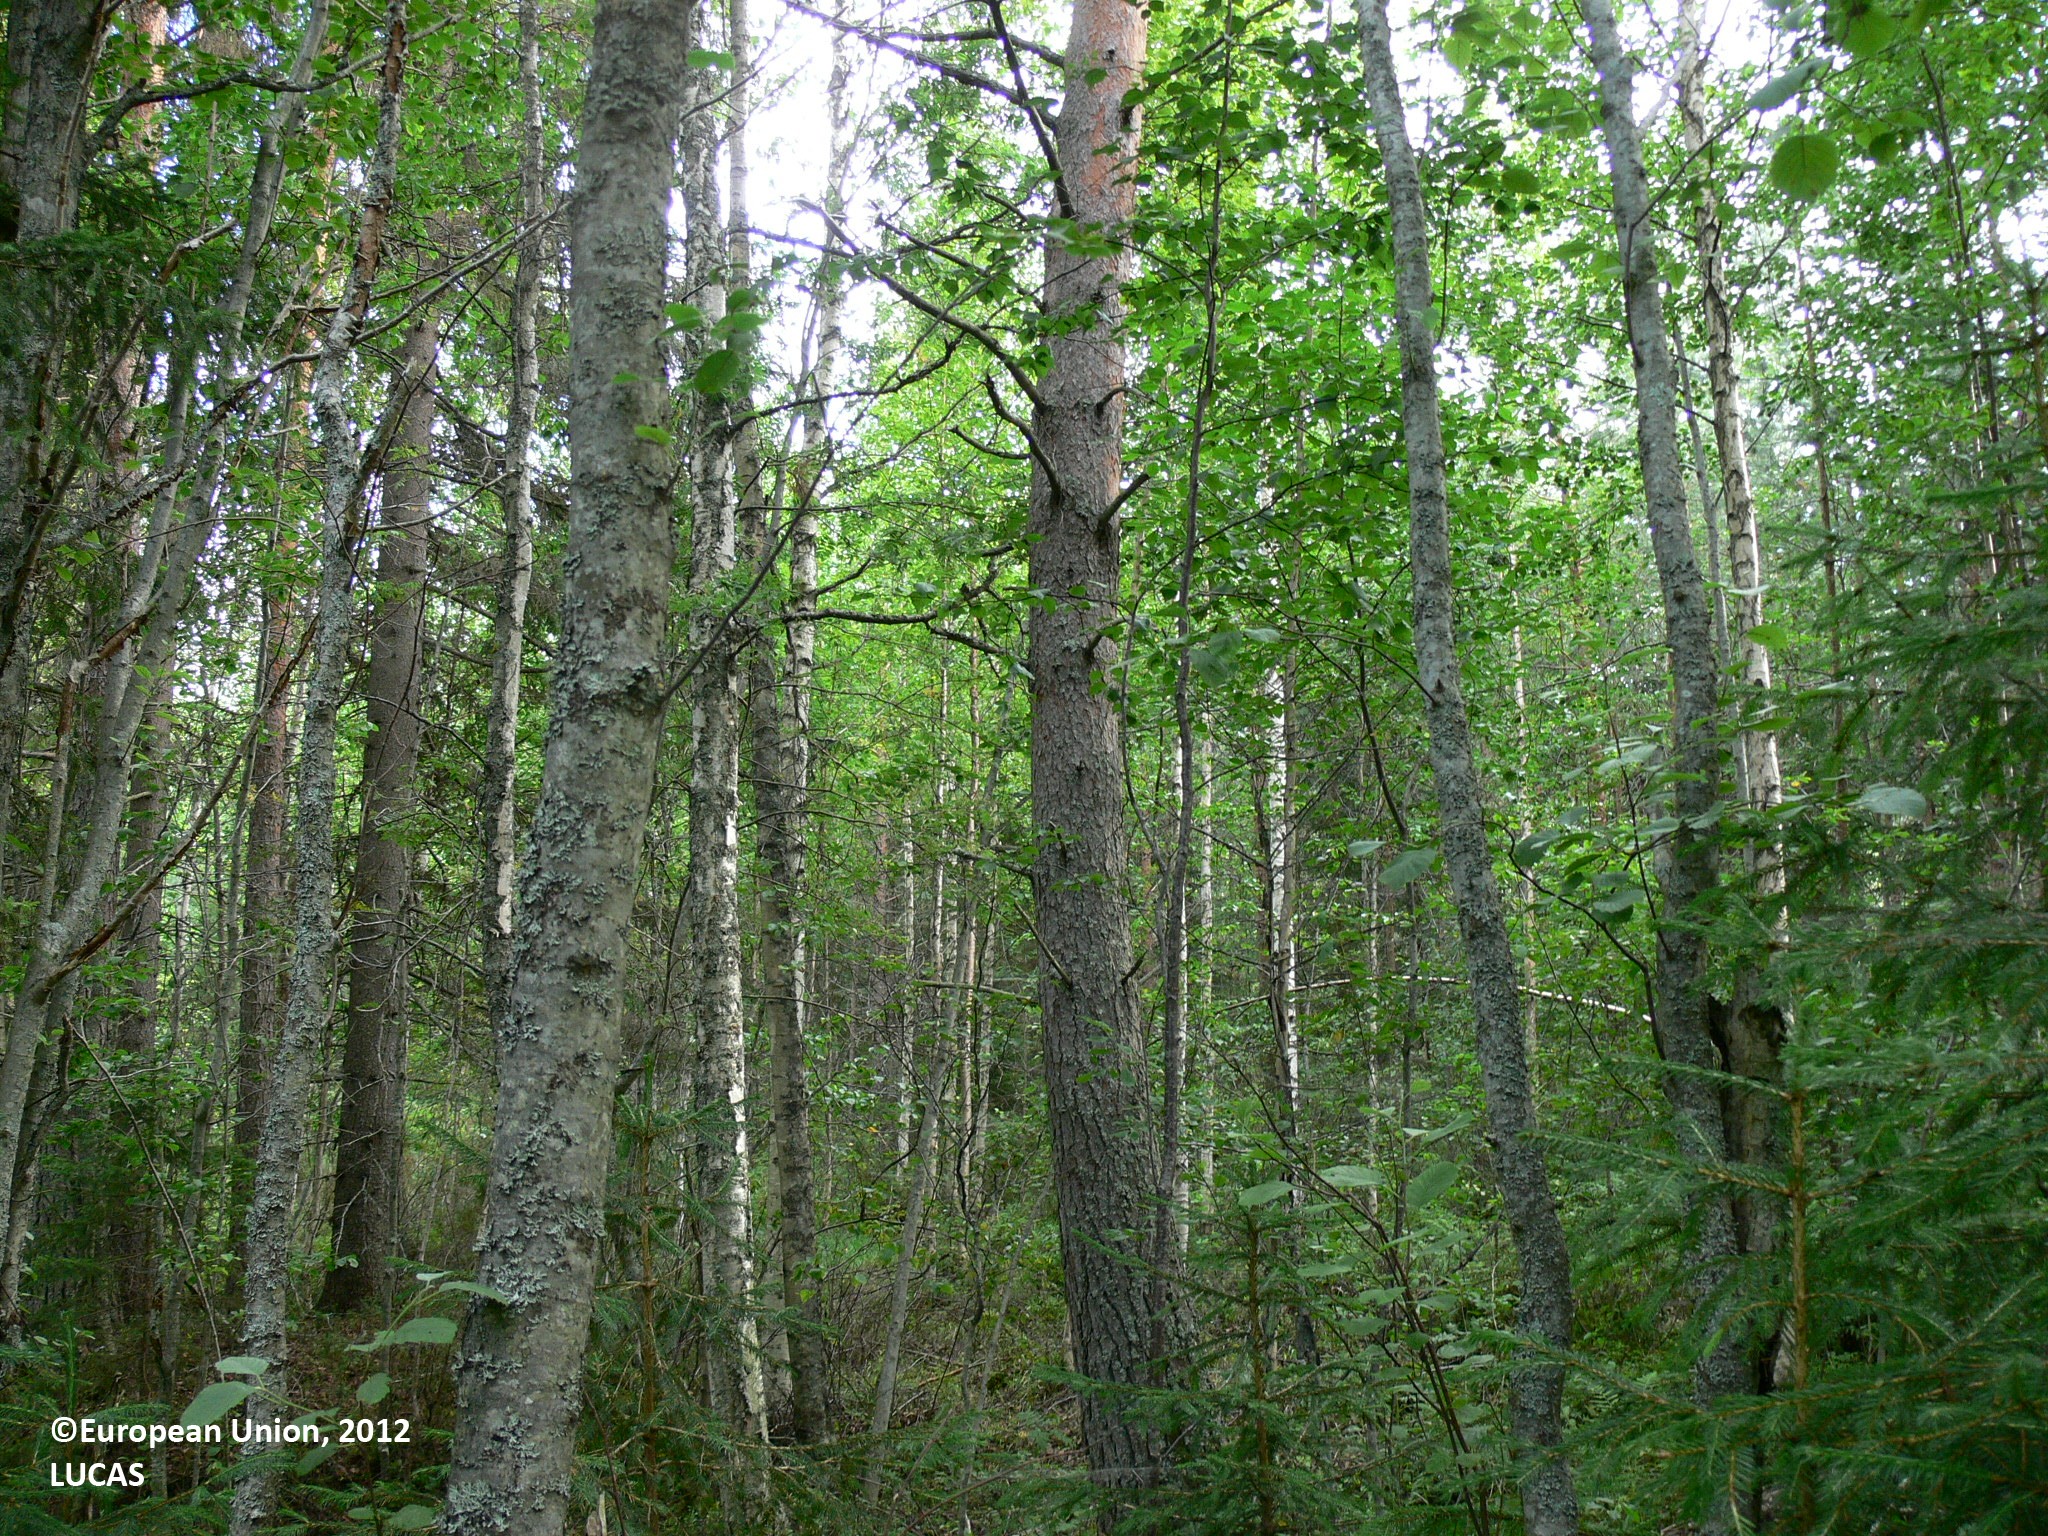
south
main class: Woodland
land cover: Other mixed woodland
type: boreal forest
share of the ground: > 75 %
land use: Forestry
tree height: > 5 m
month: July
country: FI
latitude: 63.1831
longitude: 29.5242
